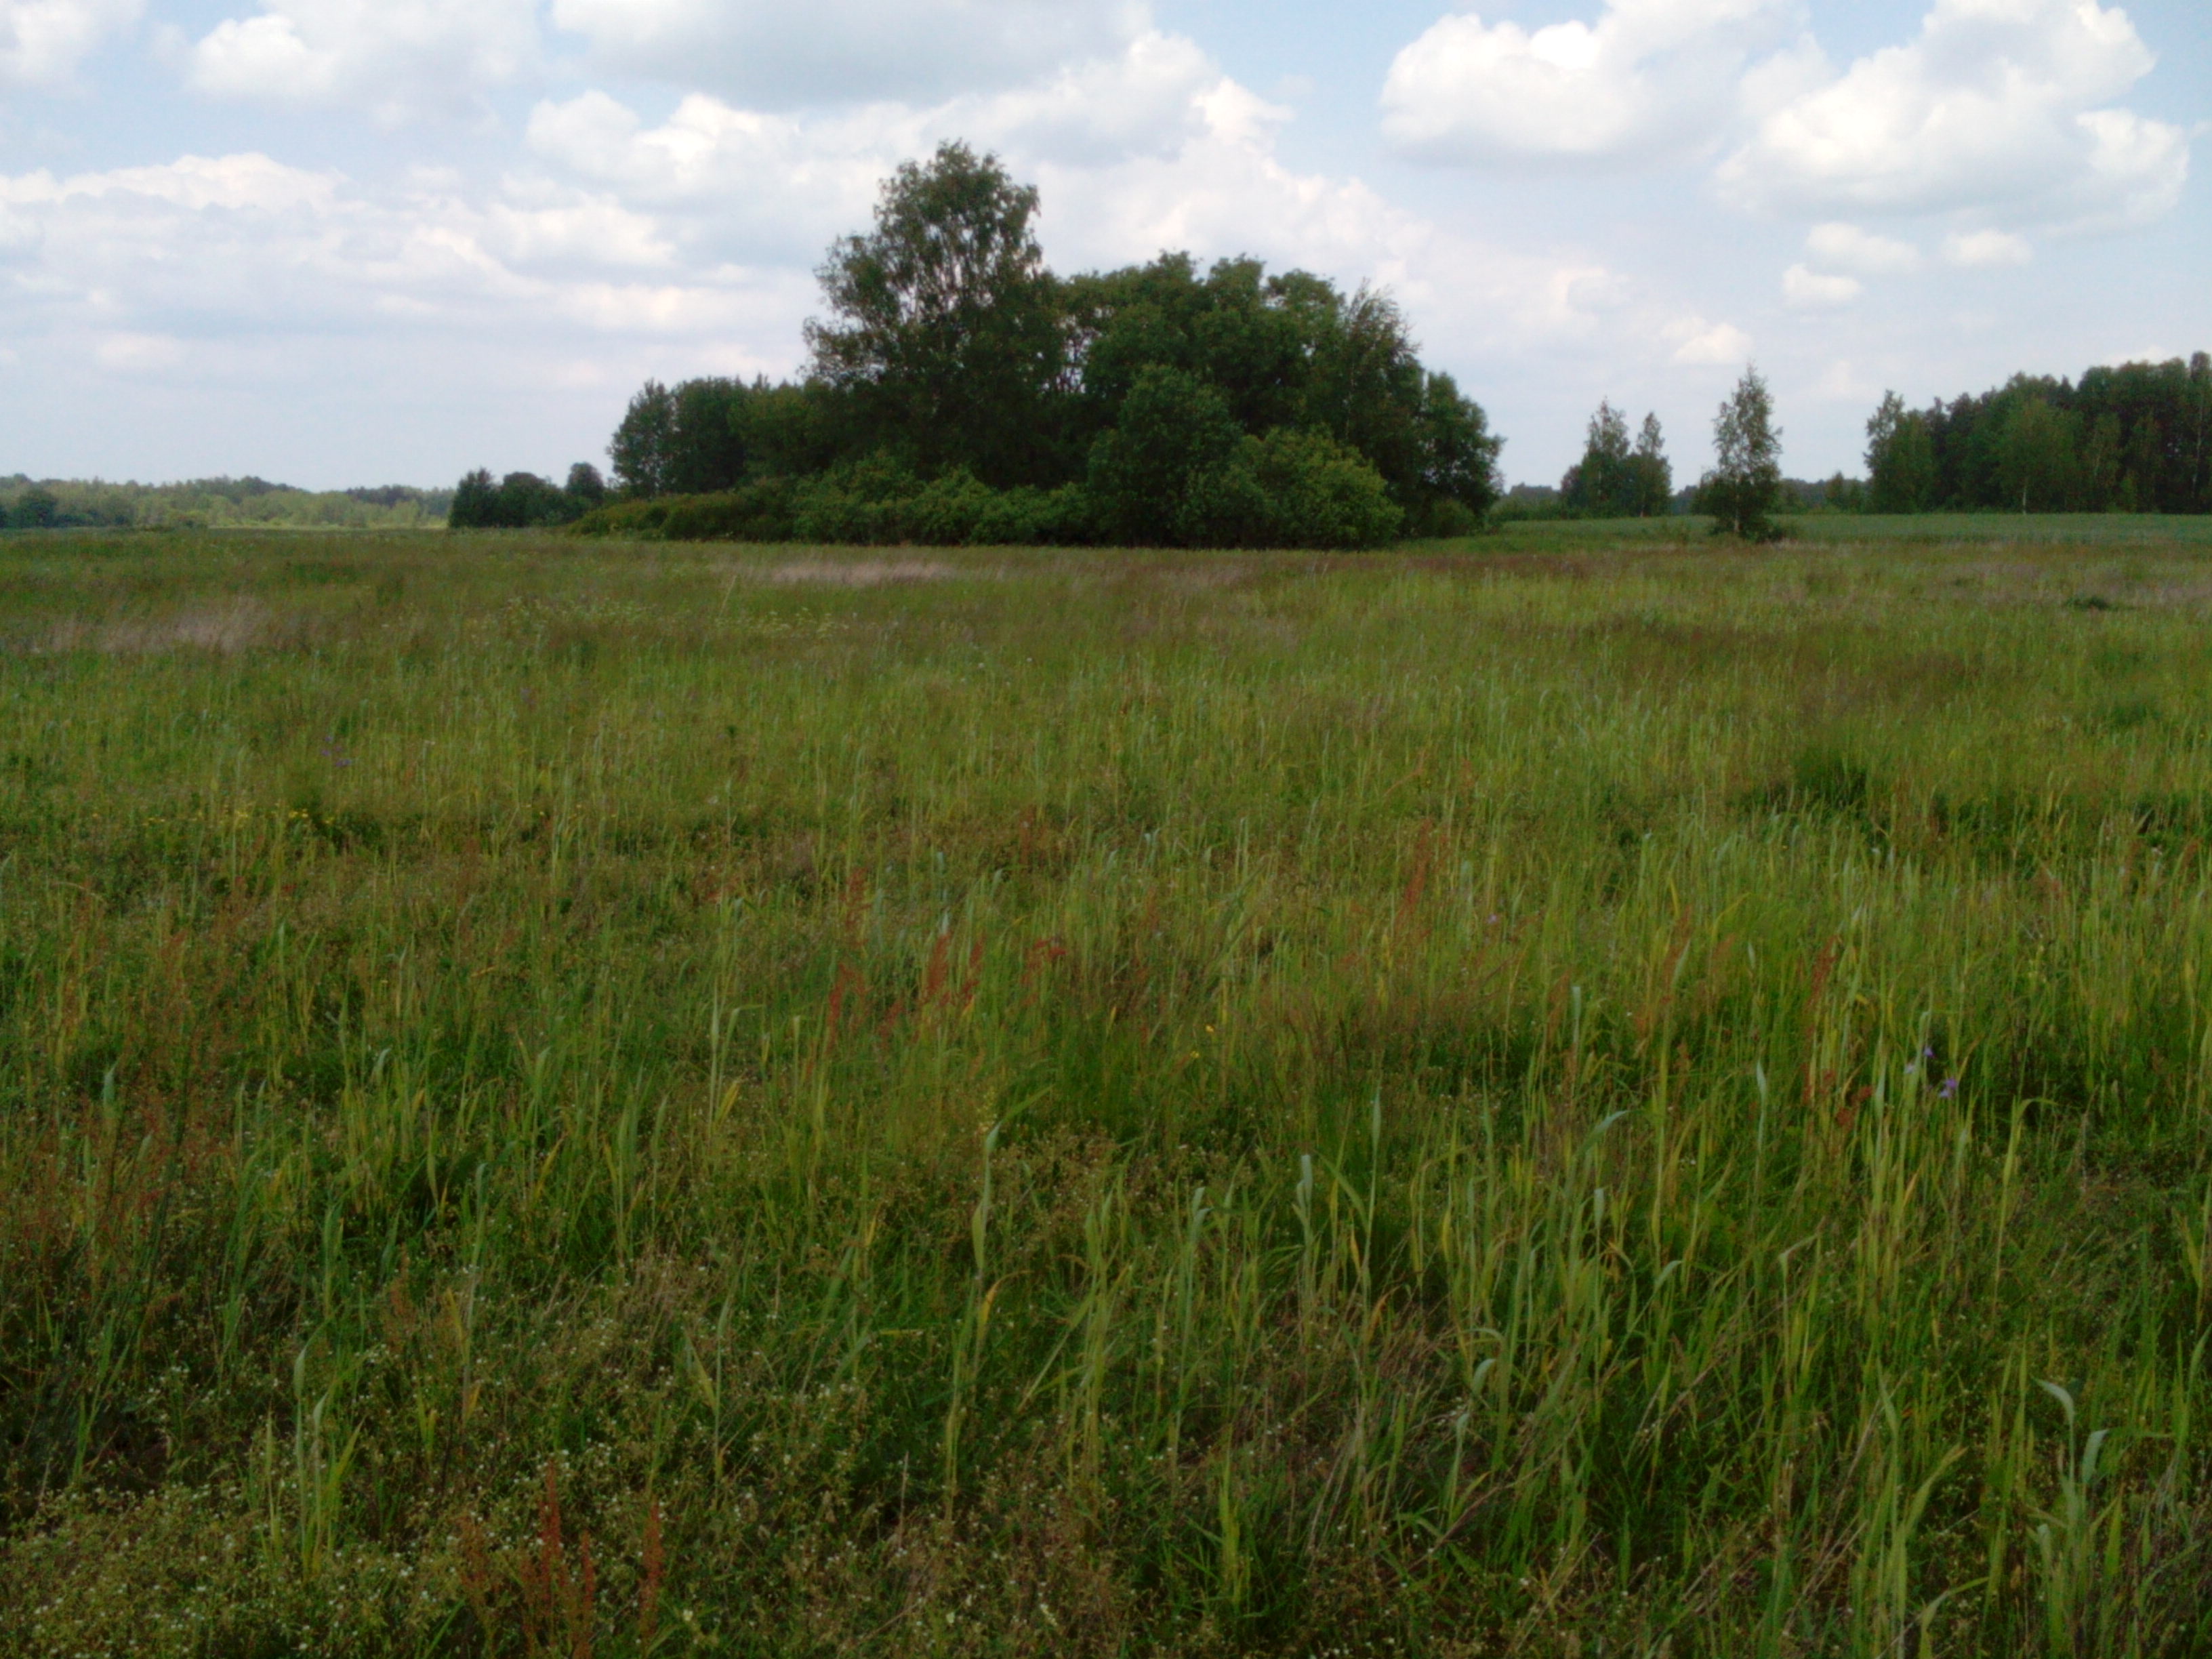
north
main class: Grassland
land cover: Grassland without tree/shrub cover
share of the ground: > 75 %
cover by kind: herbaceous plants 100 %
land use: Agriculture (excluding fallow land and kitchen gardens)
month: June
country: LV
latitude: 56.8146
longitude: 22.2894
